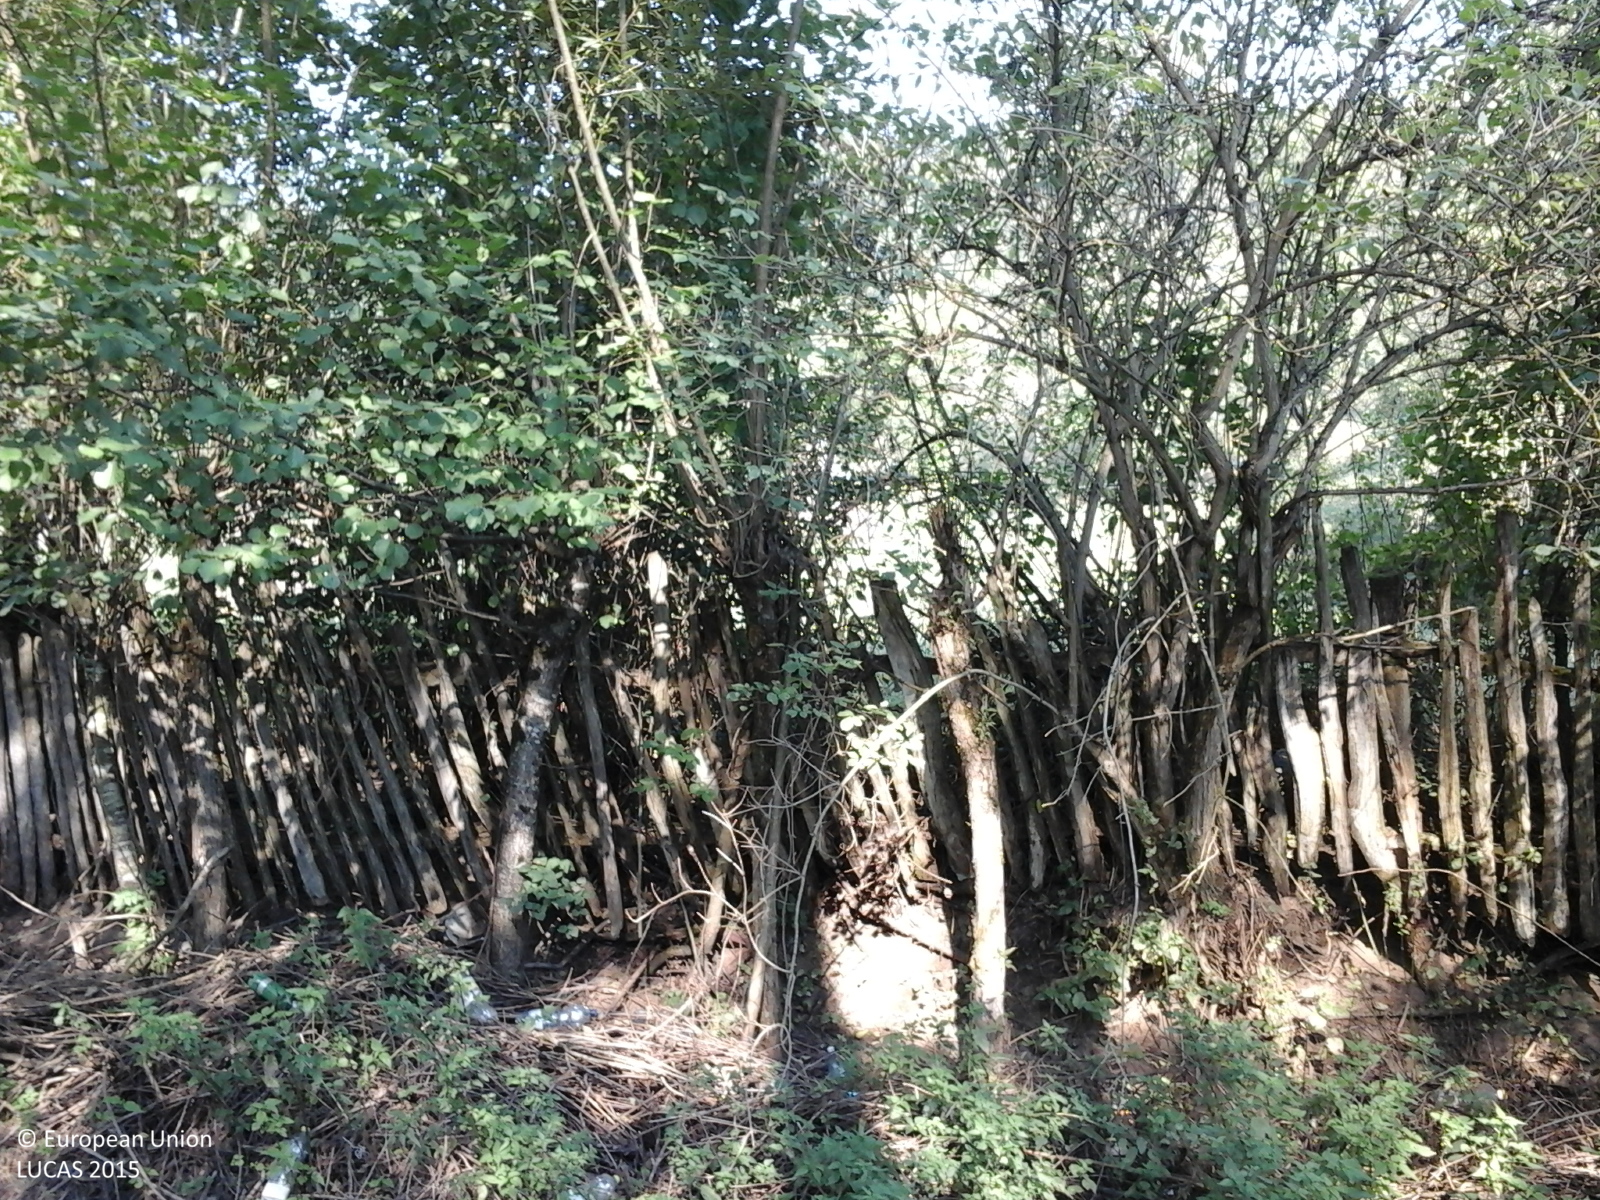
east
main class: Cropland
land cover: Lucerne
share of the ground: > 75 %
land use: Agriculture (excluding fallow land and kitchen gardens)
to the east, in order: Lucerne; Other fruit trees and berries; Broadleaved woodland
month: August
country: RO
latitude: 46.0999
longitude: 22.0864
